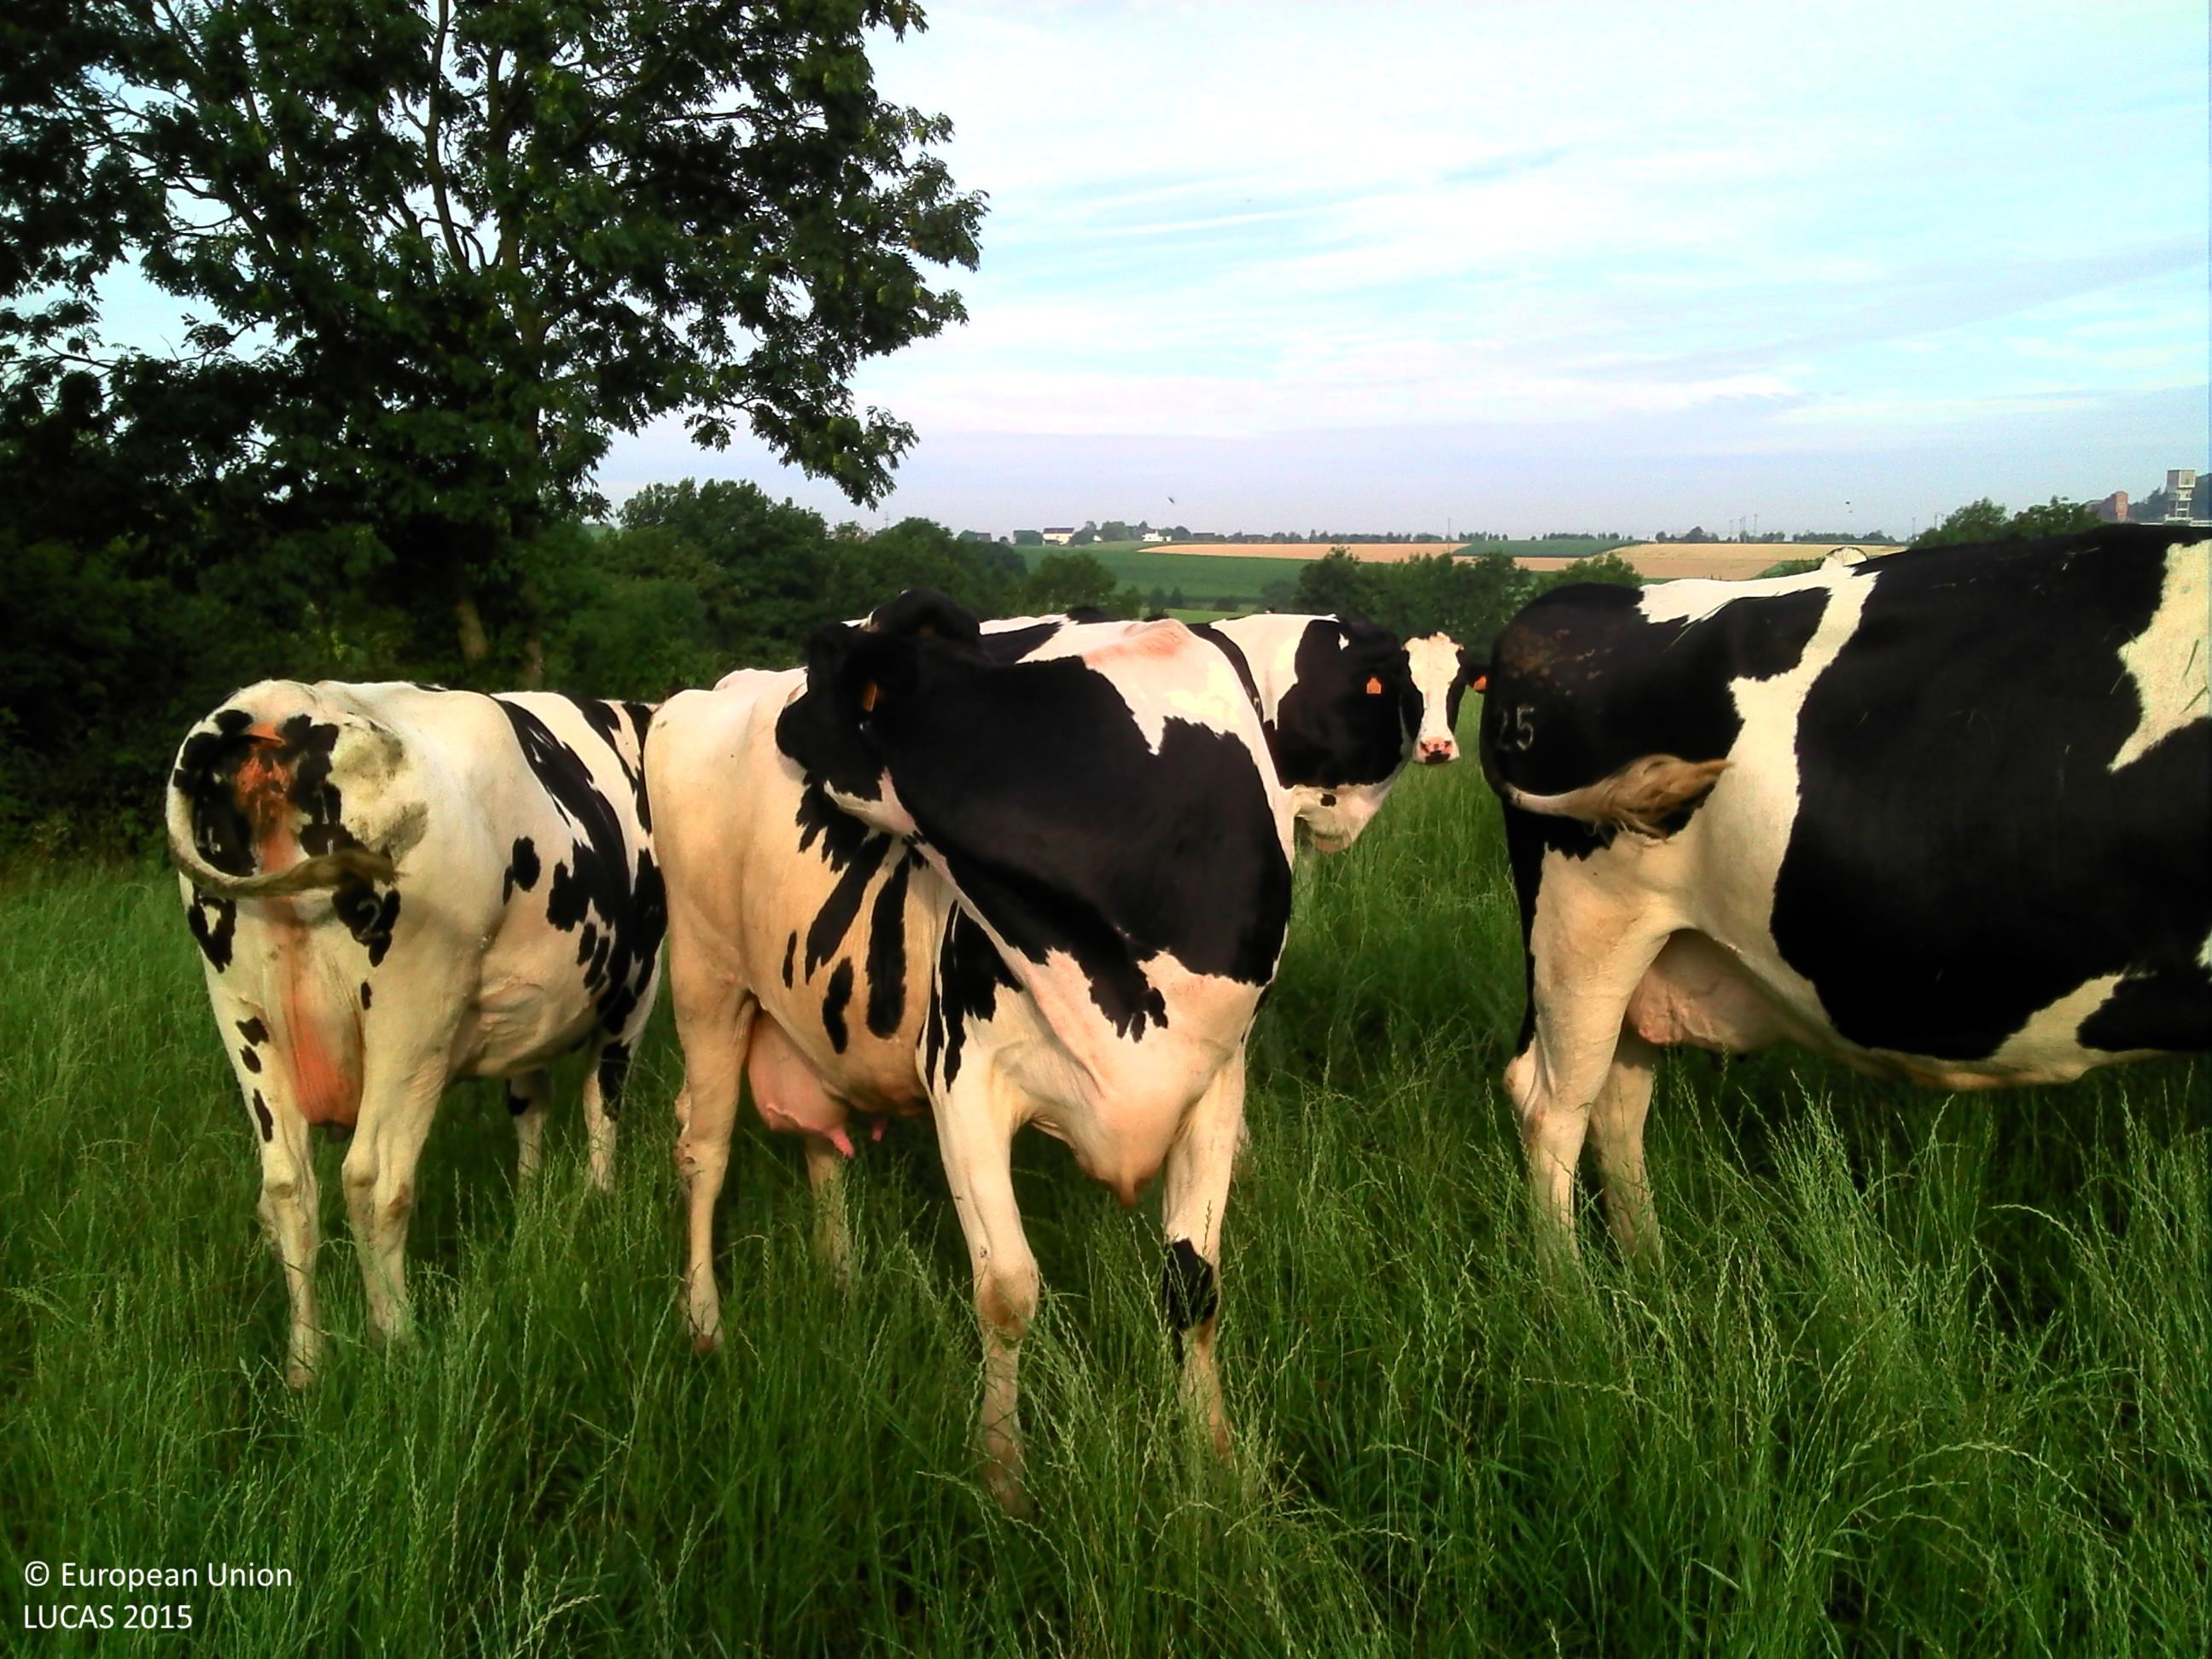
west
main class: Grassland
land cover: Grassland without tree/shrub cover
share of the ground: > 75 %
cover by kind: herbaceous plants 100 %
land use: Agriculture (excluding fallow land and kitchen gardens)
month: July
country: BE
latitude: 50.6808
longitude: 5.7387
